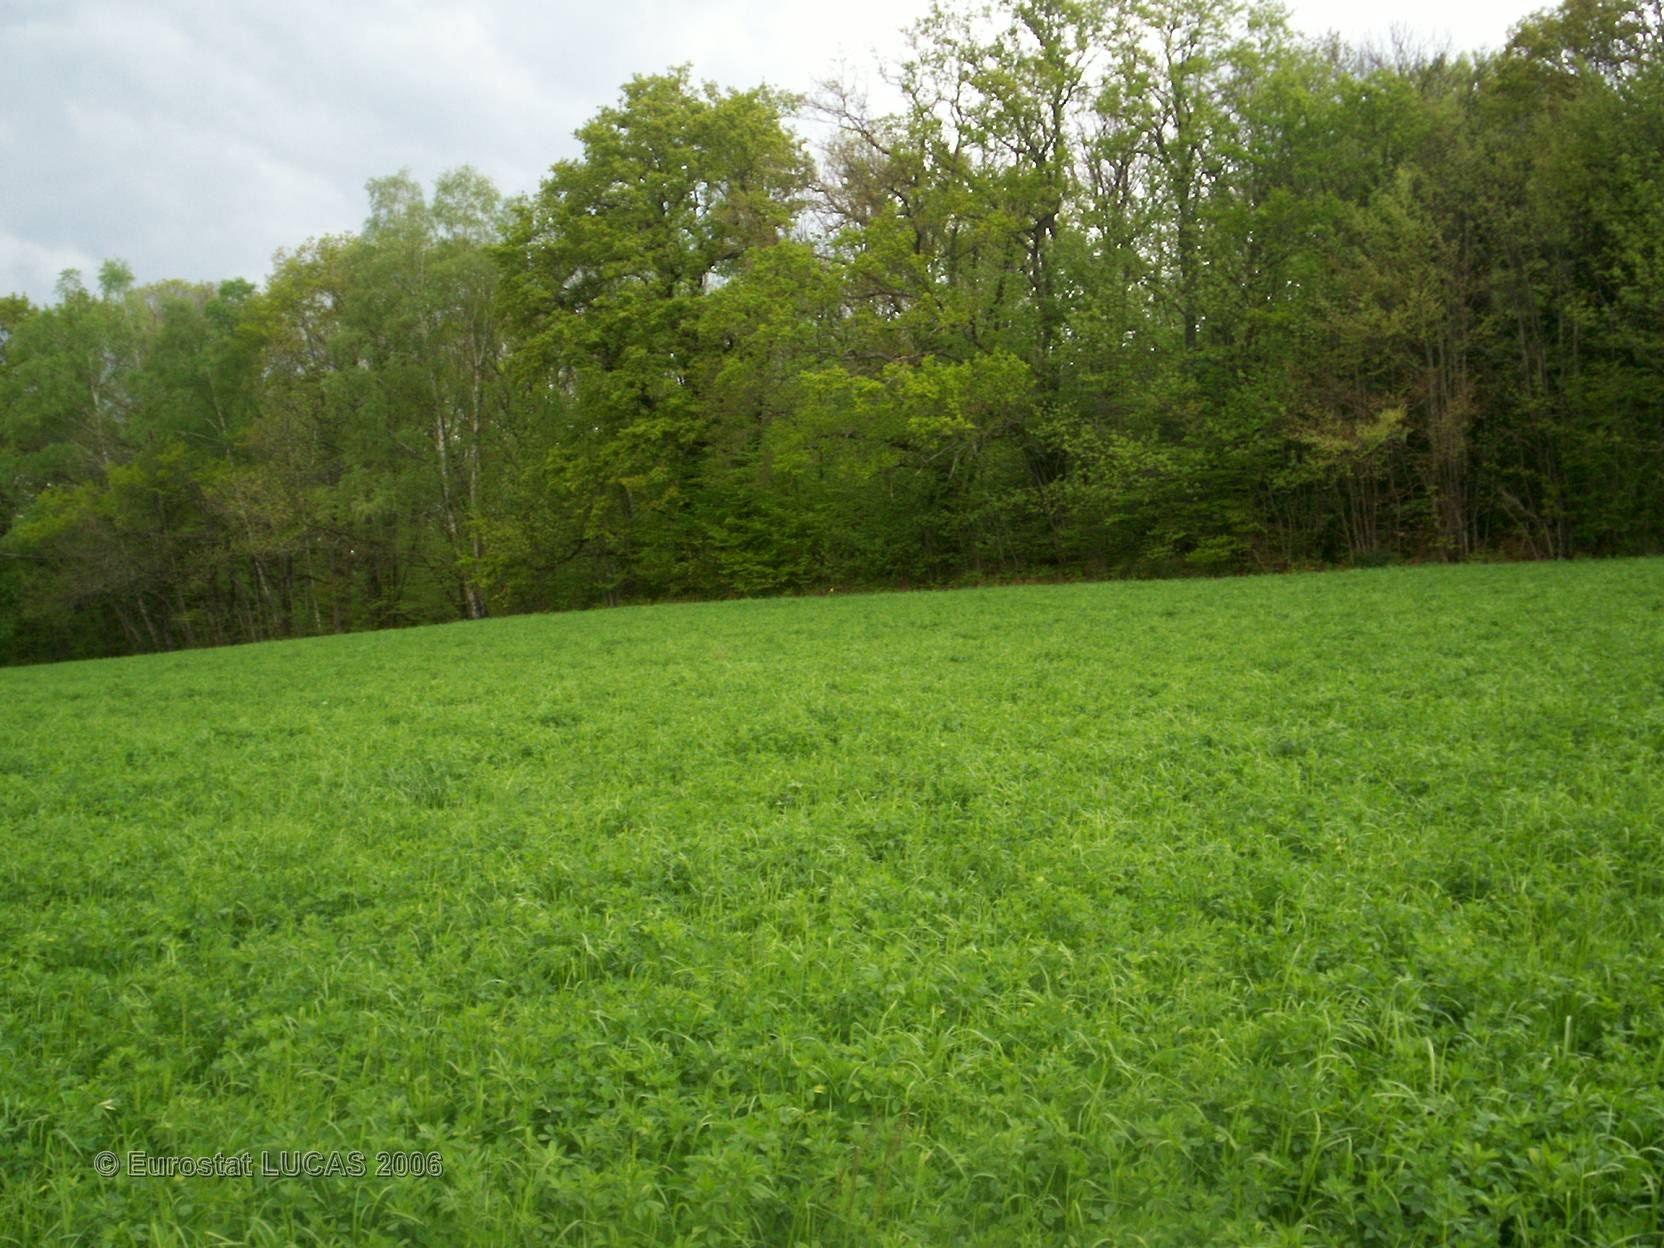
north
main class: Cropland
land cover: Lucerne
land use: Agriculture (excluding fallow land and kitchen gardens)
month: May
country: FR
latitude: 45.7446
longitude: 1.5482
